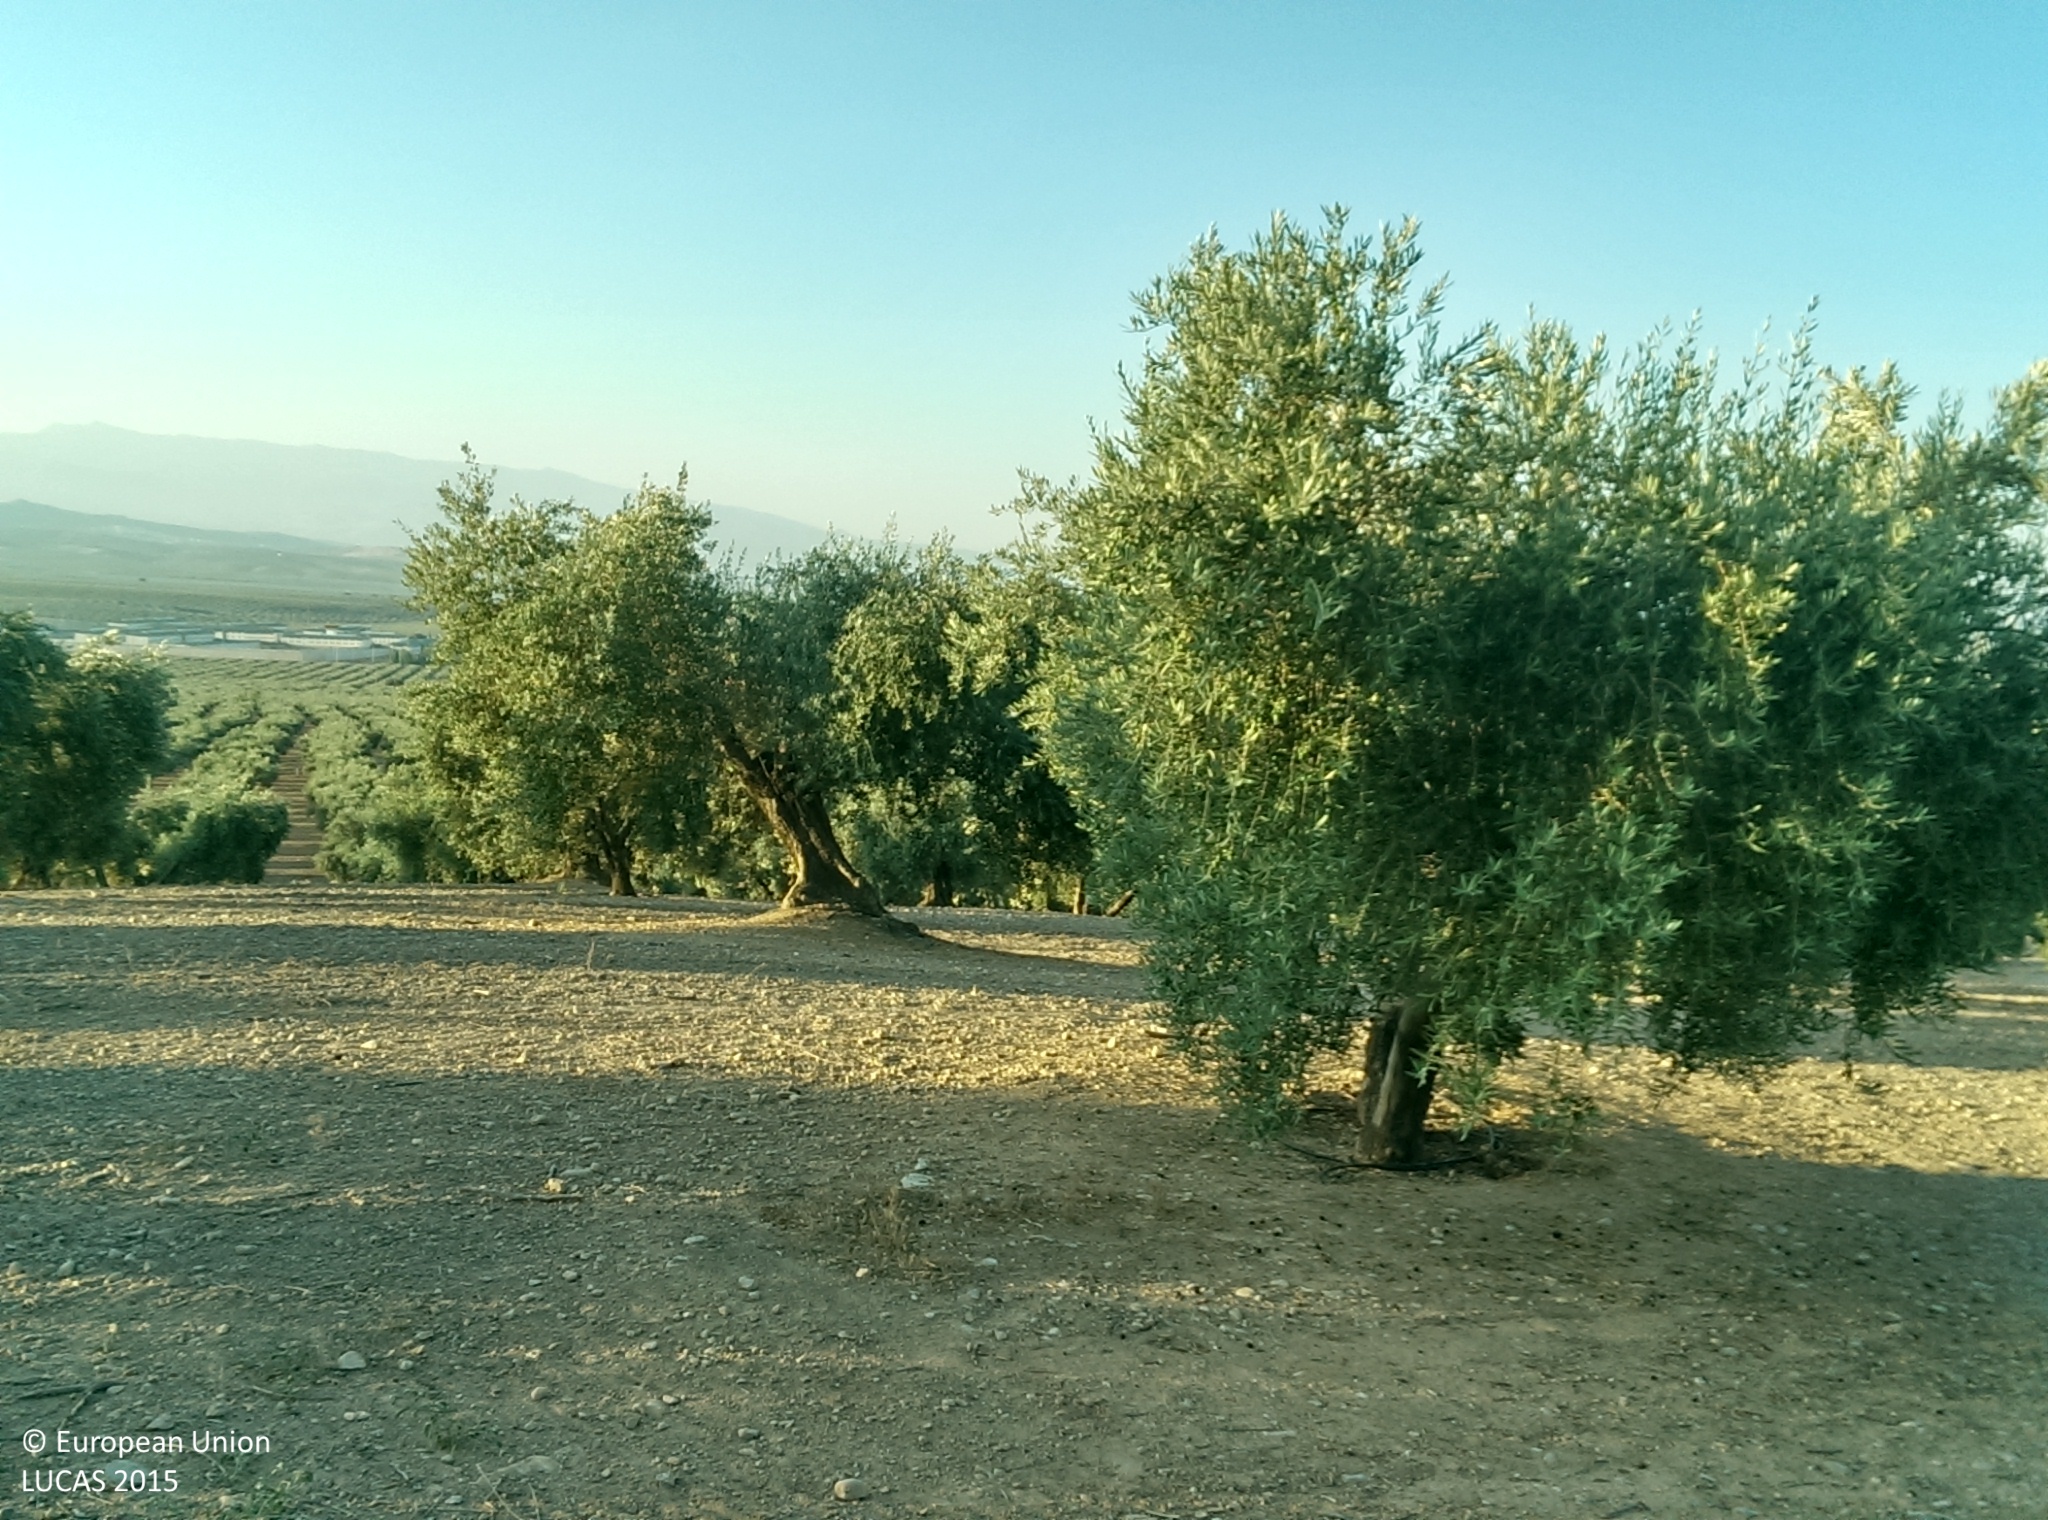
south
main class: Cropland
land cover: Olive groves
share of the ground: 50 - 75 %
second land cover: Other bare soil
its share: > 75 %
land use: Agriculture (excluding fallow land and kitchen gardens)
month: July
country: ES
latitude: 37.3408
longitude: -3.6846
